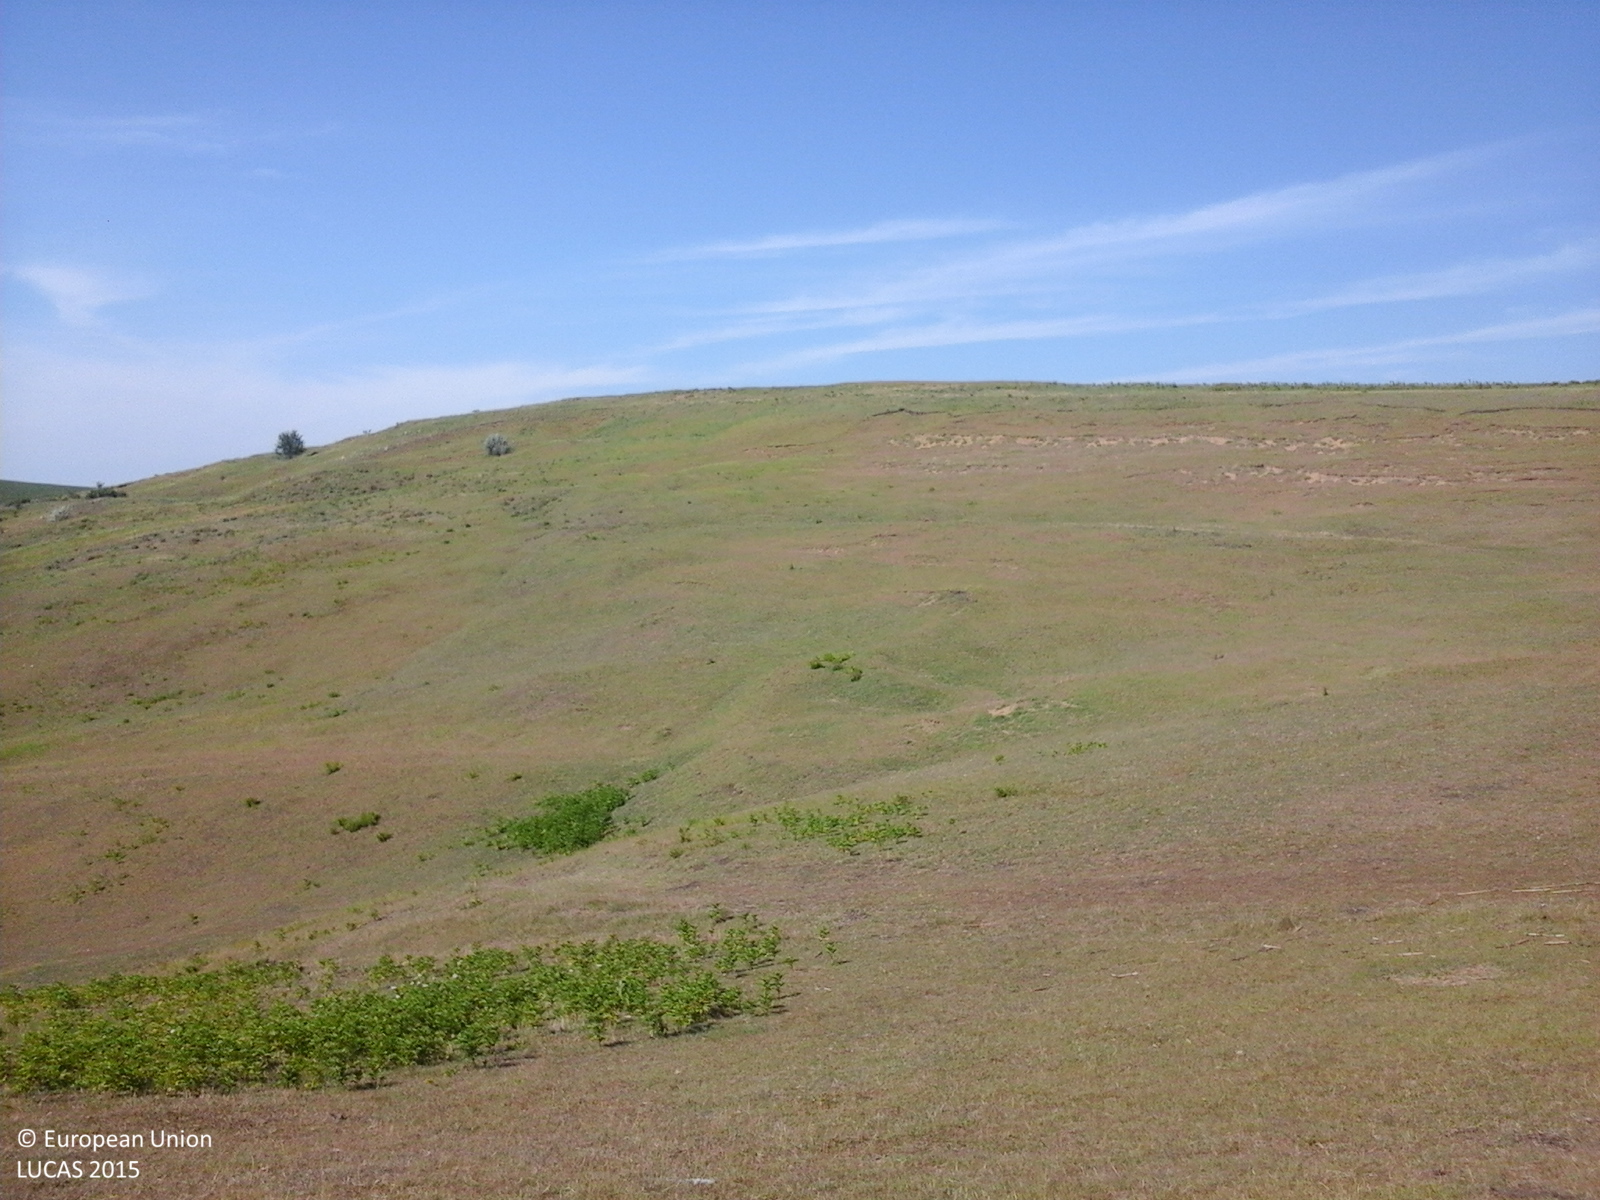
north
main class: Grassland
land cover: Grassland without tree/shrub cover
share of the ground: > 75 %
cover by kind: herbaceous plants 100 %
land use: Agriculture (excluding fallow land and kitchen gardens)
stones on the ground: < 10 %
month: June
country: RO
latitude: 47.3290
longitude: 27.2452
